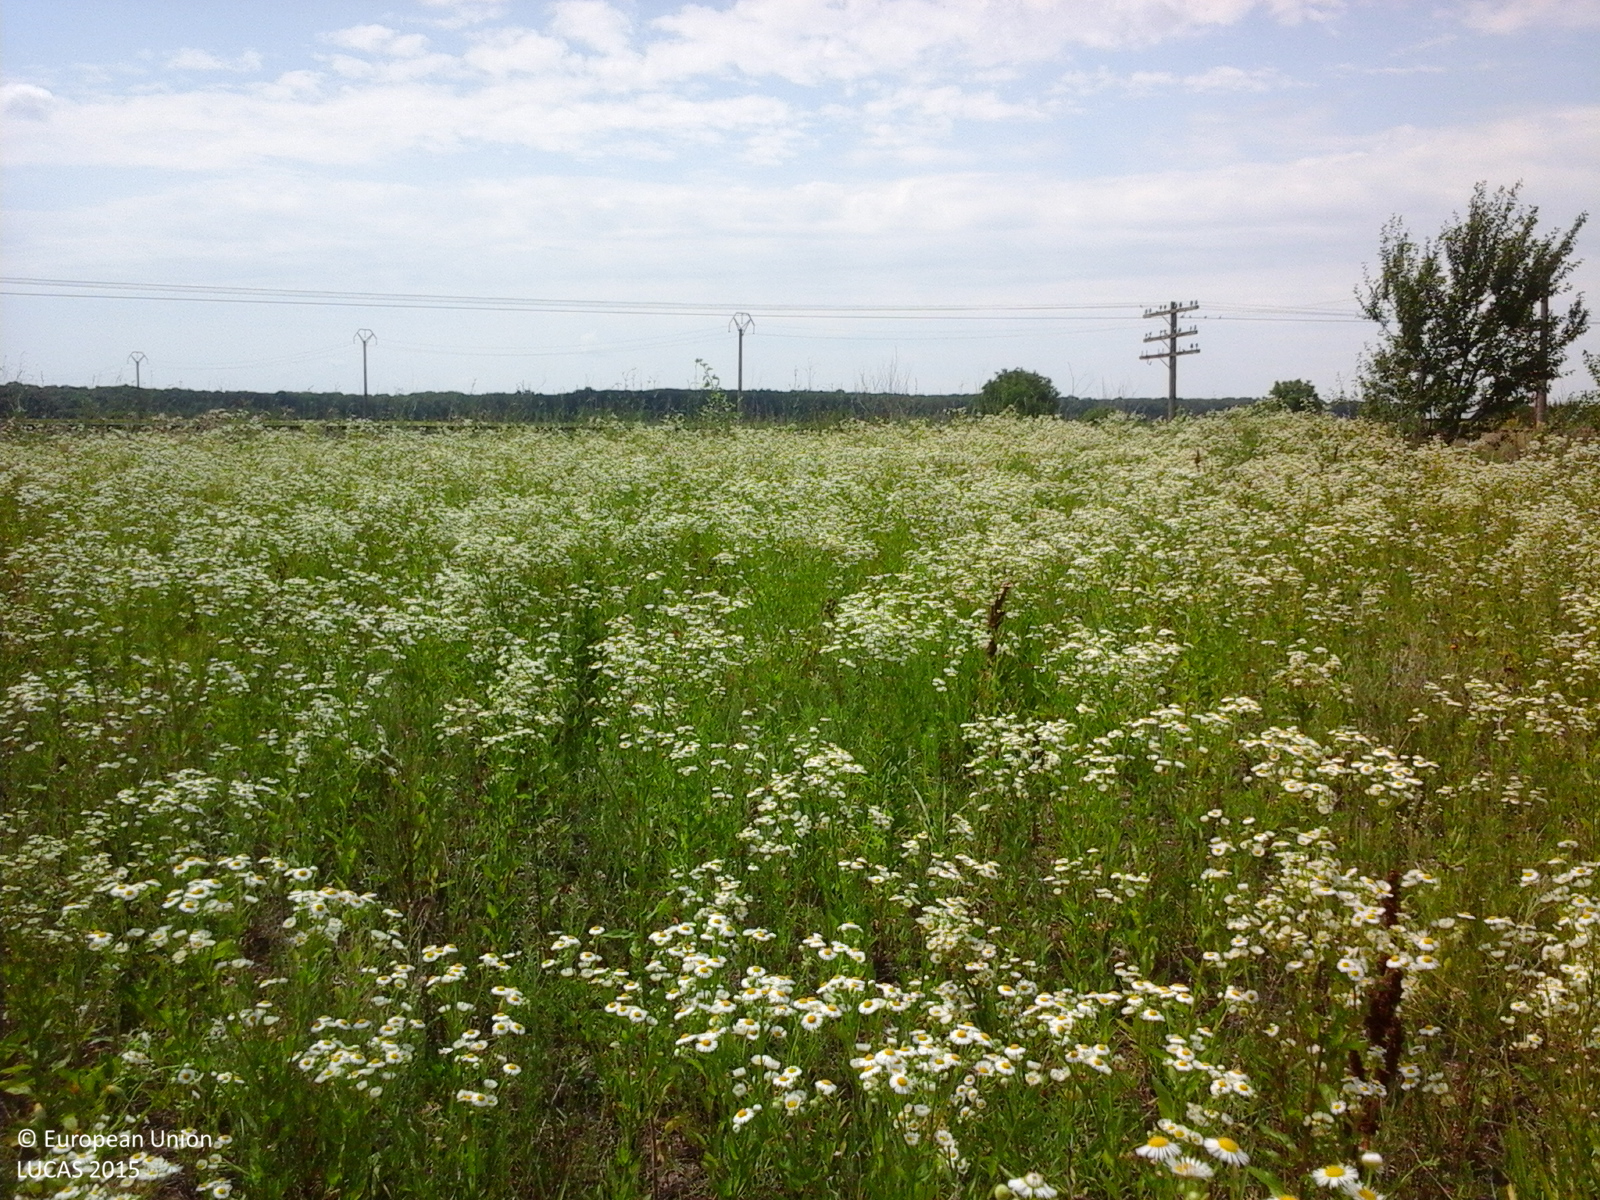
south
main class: Grassland
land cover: Spontaneously vegetated surfaces
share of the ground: > 75 %
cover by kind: herbaceous plants 100 %
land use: Agriculture (excluding fallow land and kitchen gardens)
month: June
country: RO
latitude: 44.6412
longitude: 26.2354
